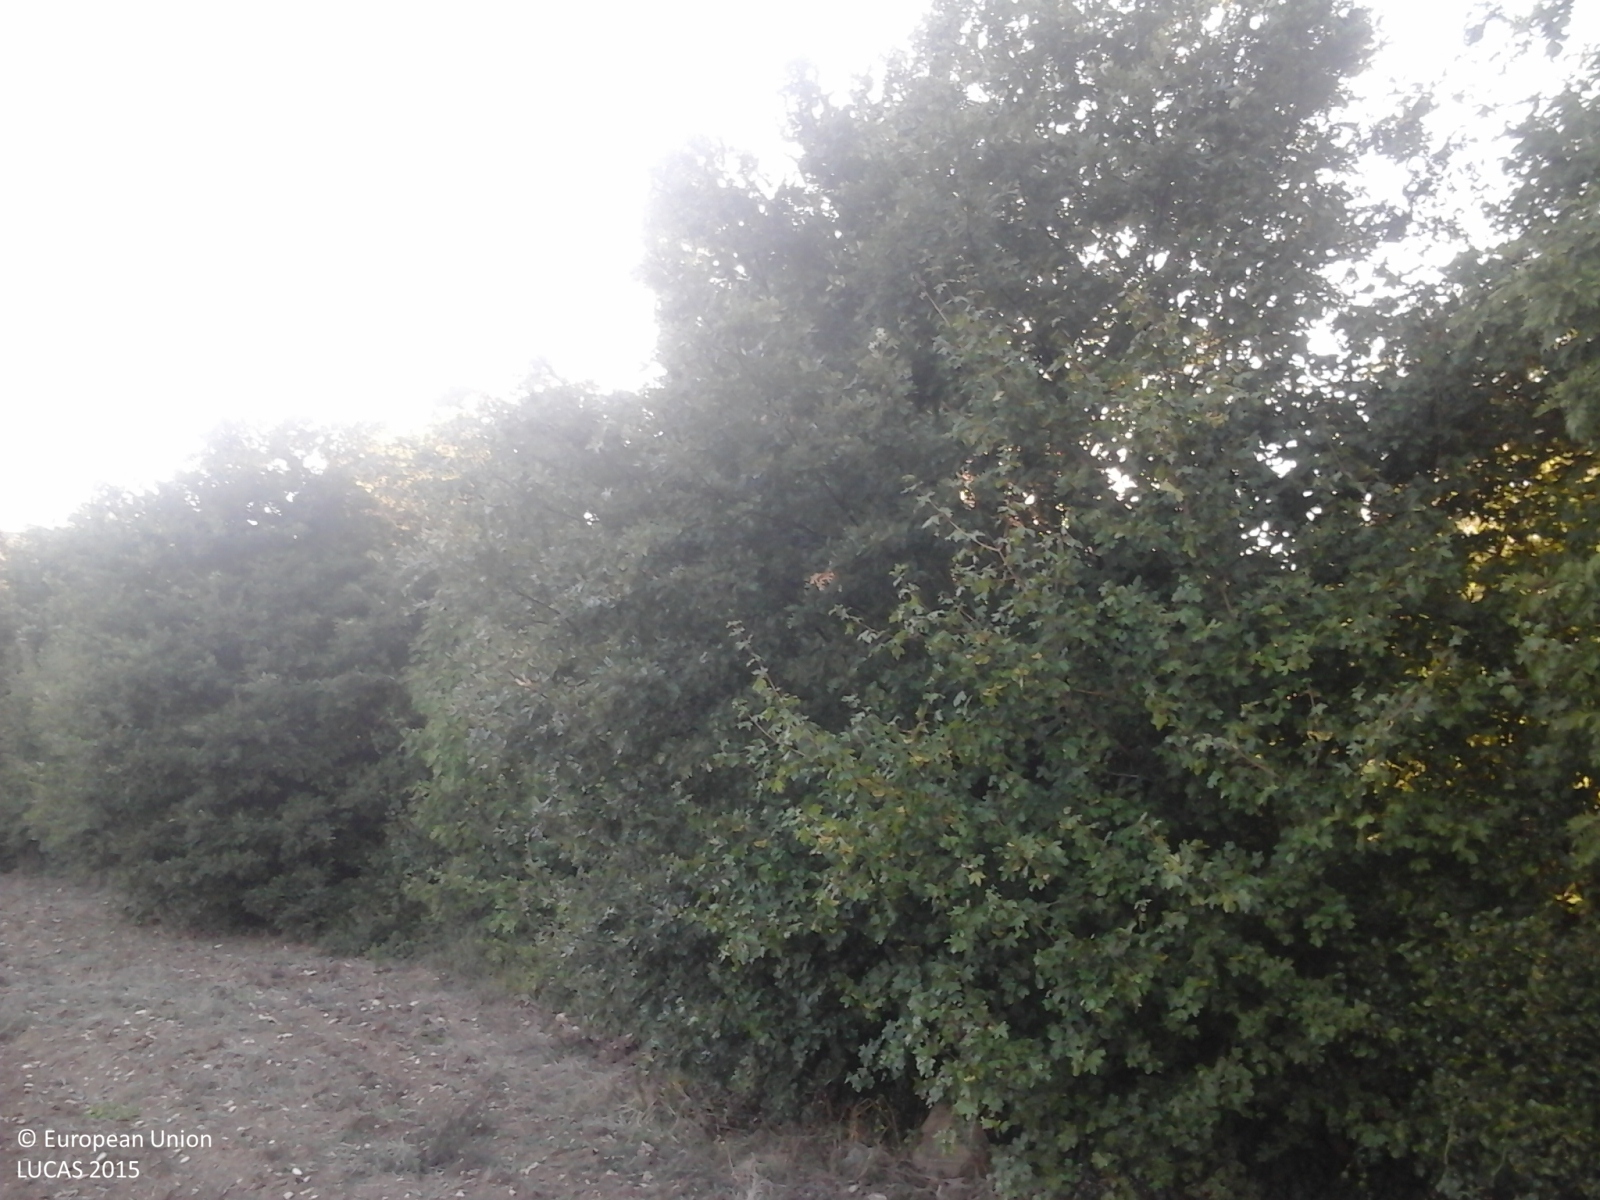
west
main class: Woodland
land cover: Broadleaved woodland
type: thermophilous deciduous forest
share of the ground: > 75 %
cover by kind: broadleaved forest trees 70 %, shrubs 20 %, herbaceous plants 10 %
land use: Forestry
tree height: > 5 m
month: August
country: IT
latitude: 42.8254
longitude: 12.3535
